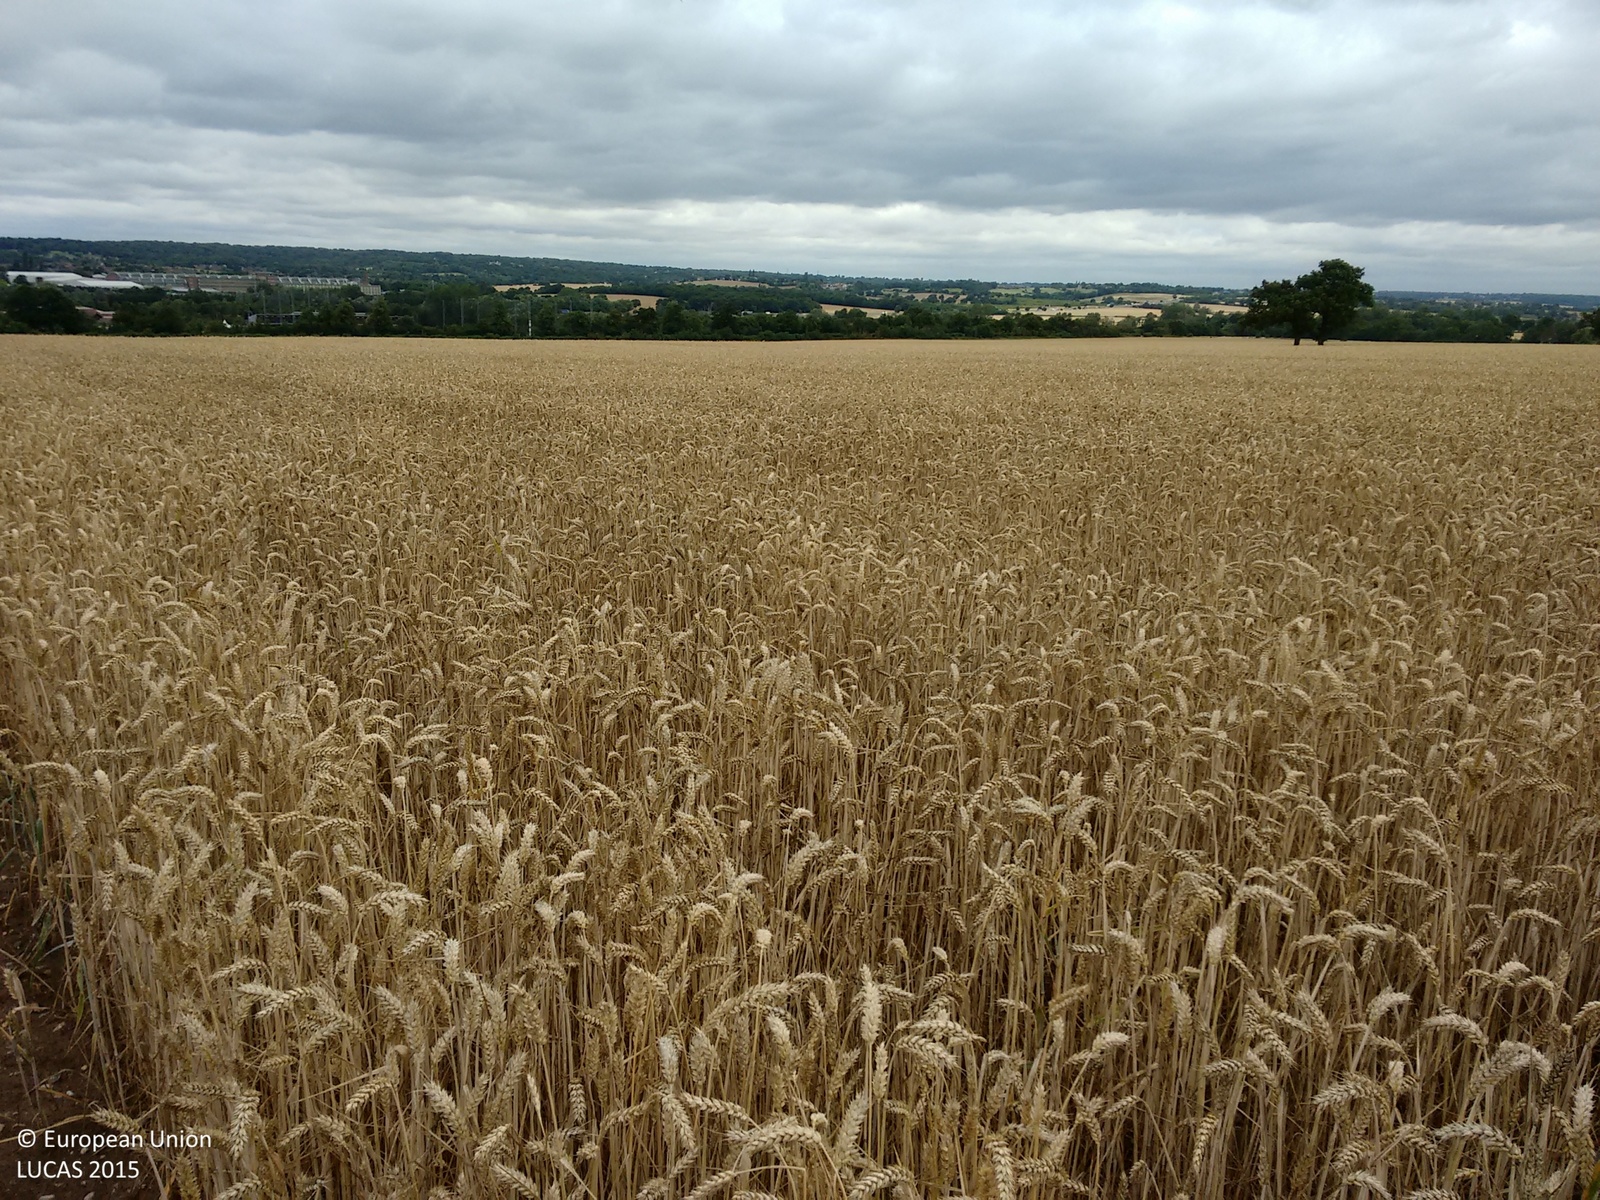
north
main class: Cropland
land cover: Common wheat
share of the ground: > 75 %
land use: Agriculture (excluding fallow land and kitchen gardens)
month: July
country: GB
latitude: 51.6365
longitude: 0.0996
